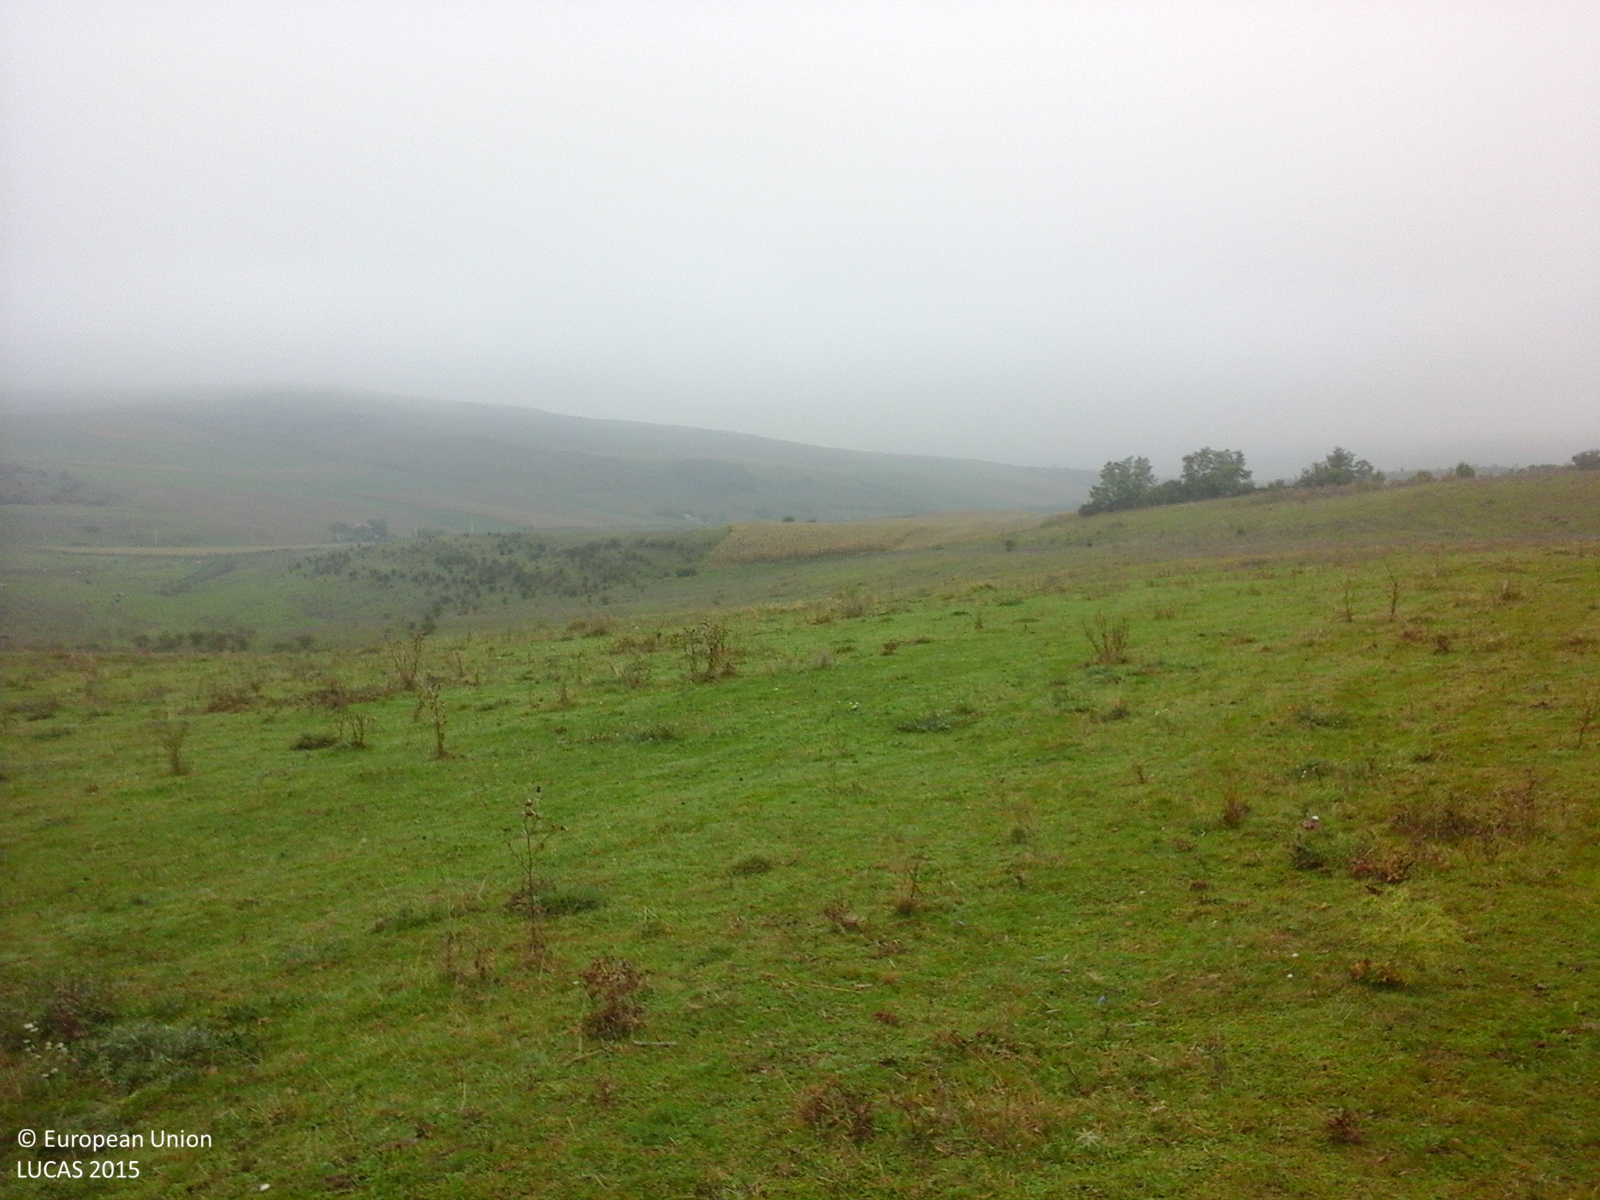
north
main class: Grassland
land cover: Grassland with sparse tree/shrub cover
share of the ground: > 75 %
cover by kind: herbaceous plants 95 %, broadleaved forest trees 5 %
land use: Agriculture (excluding fallow land and kitchen gardens)
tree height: < 5 m
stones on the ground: < 10 %
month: October
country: RO
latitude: 46.6723
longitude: 24.3726
